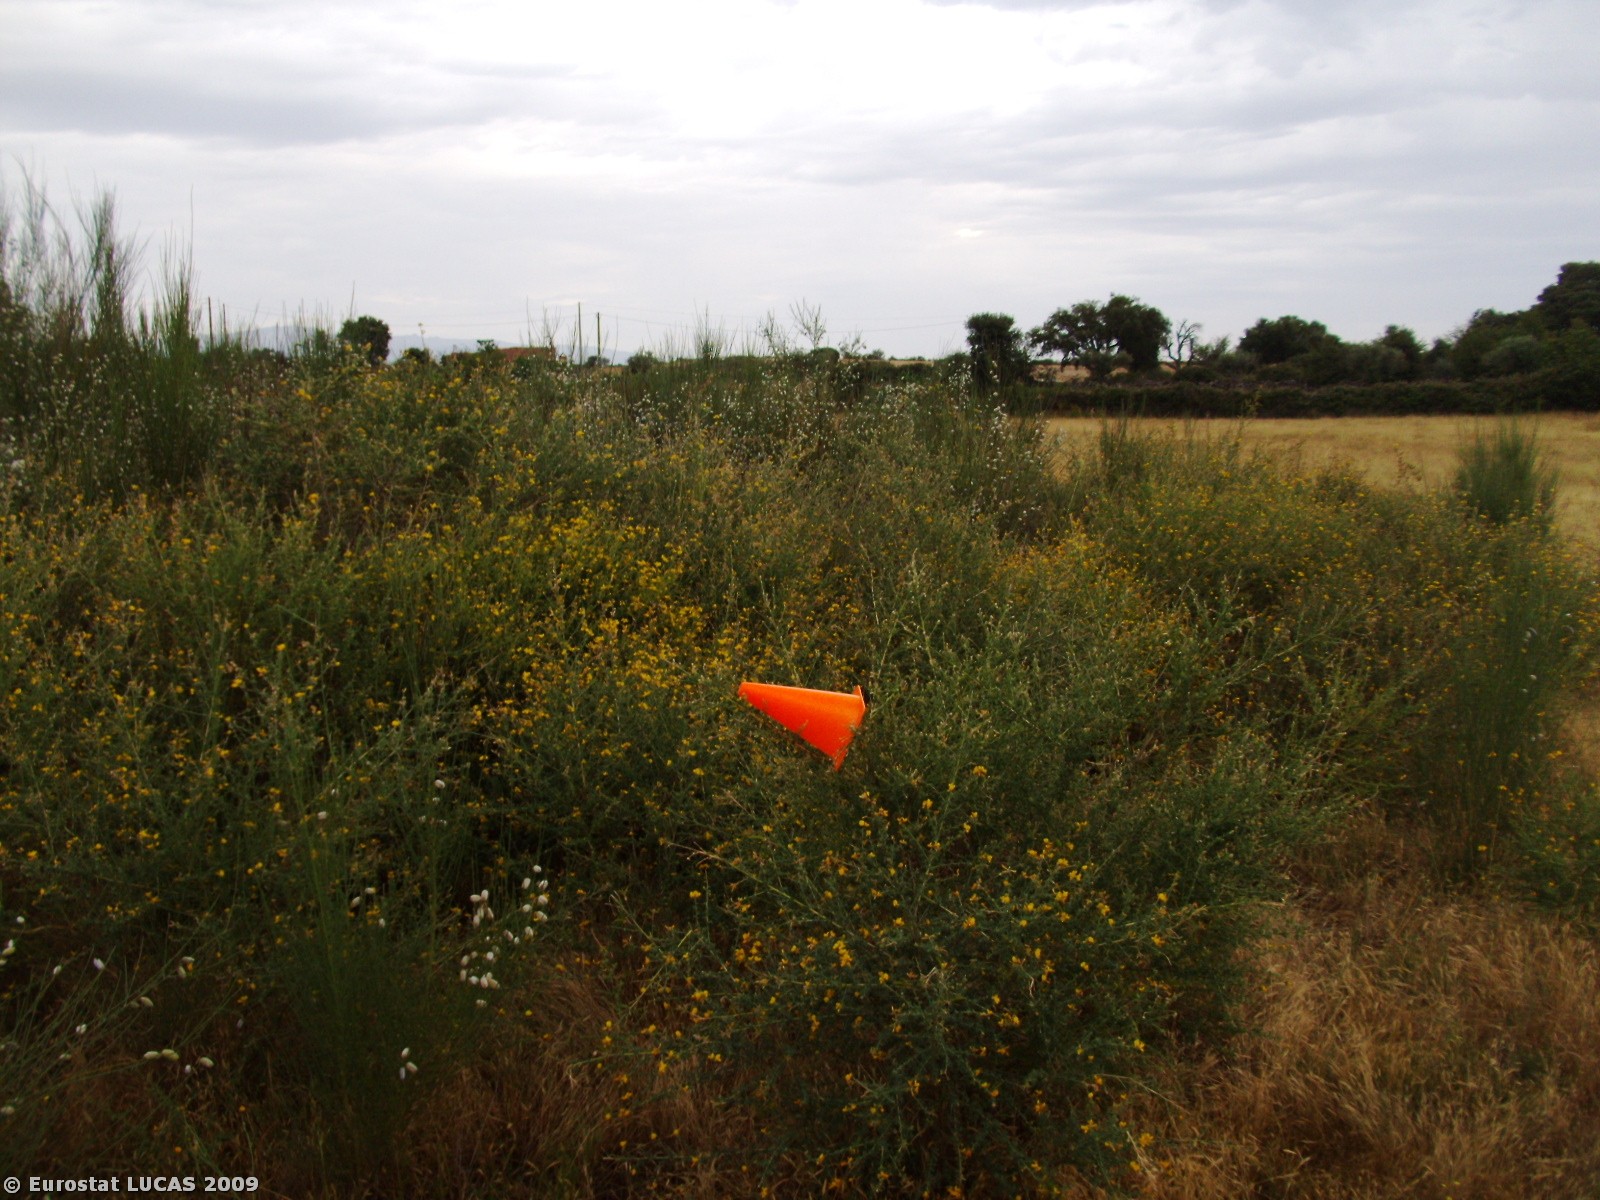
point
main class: Grassland
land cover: Spontaneously vegetated surfaces
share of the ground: > 75 %
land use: Fallow land
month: June
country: PT
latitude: 39.9178
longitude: -7.4976
